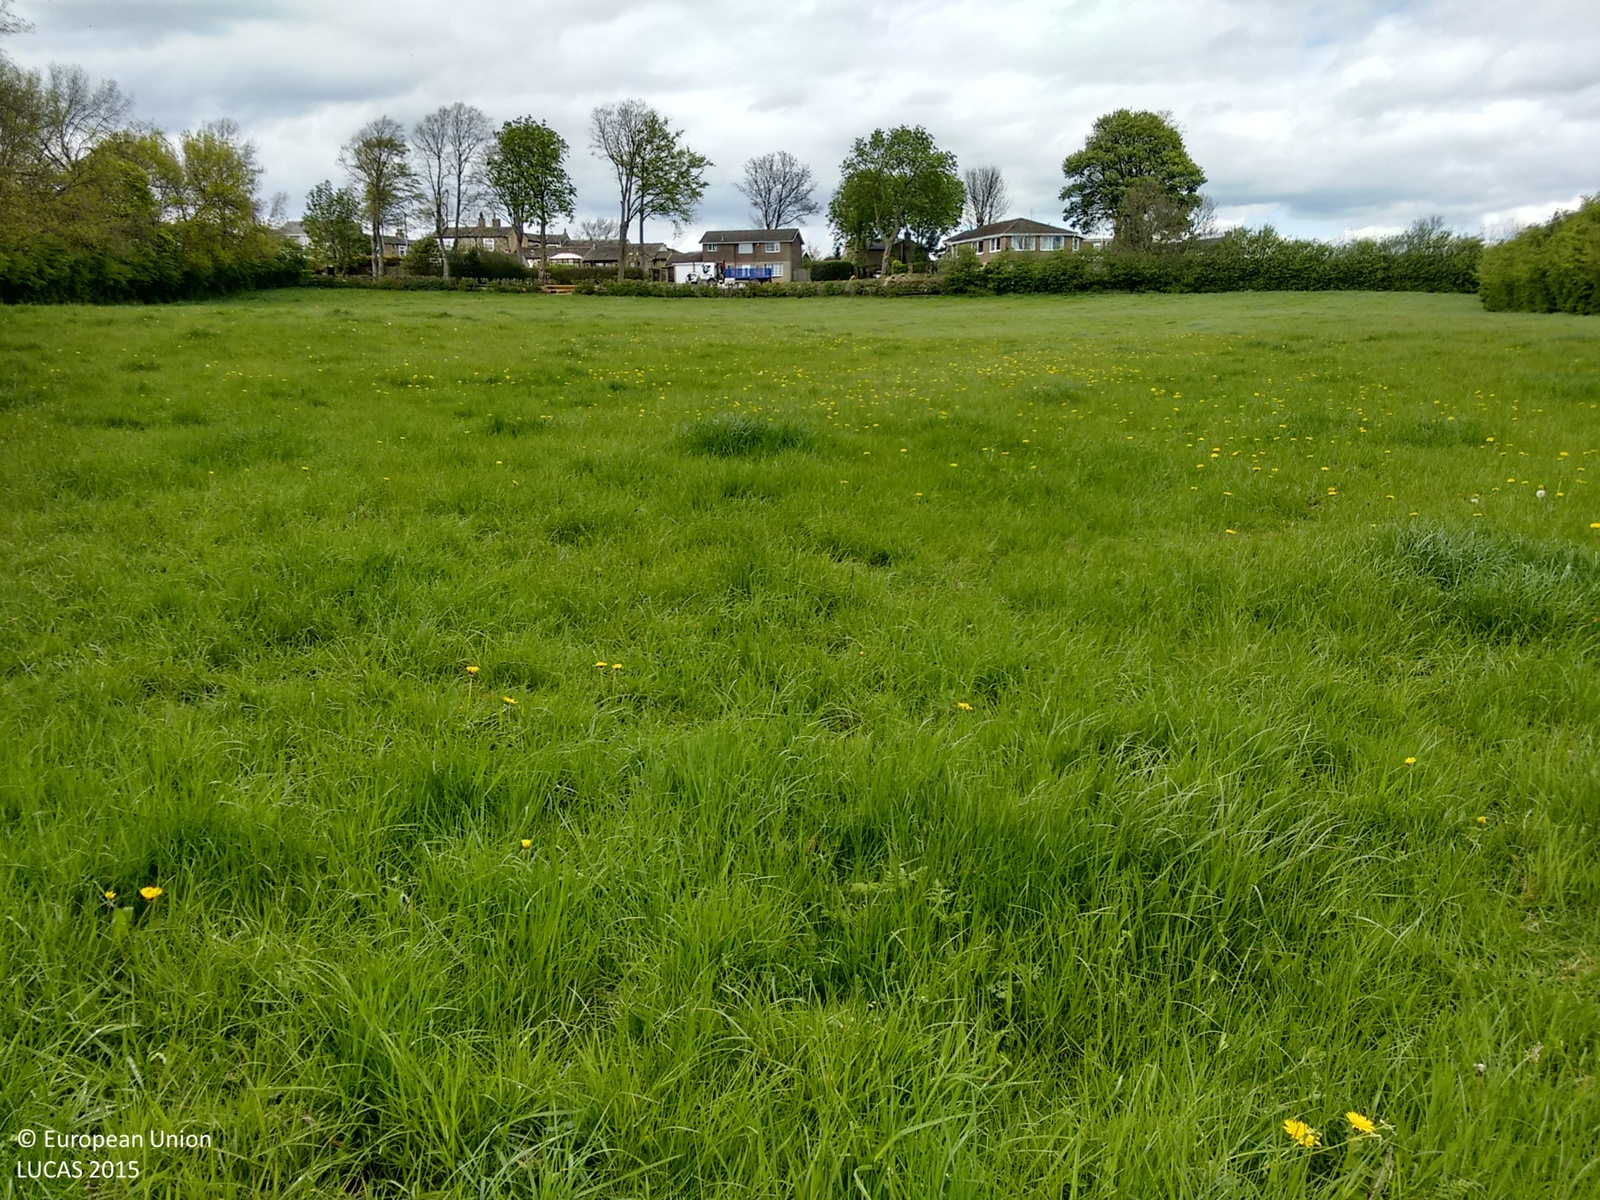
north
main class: Grassland
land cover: Grassland without tree/shrub cover
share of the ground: > 75 %
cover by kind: herbaceous plants 100 %
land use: Agriculture (excluding fallow land and kitchen gardens)
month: May
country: GB
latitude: 53.7430
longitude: -1.6819
